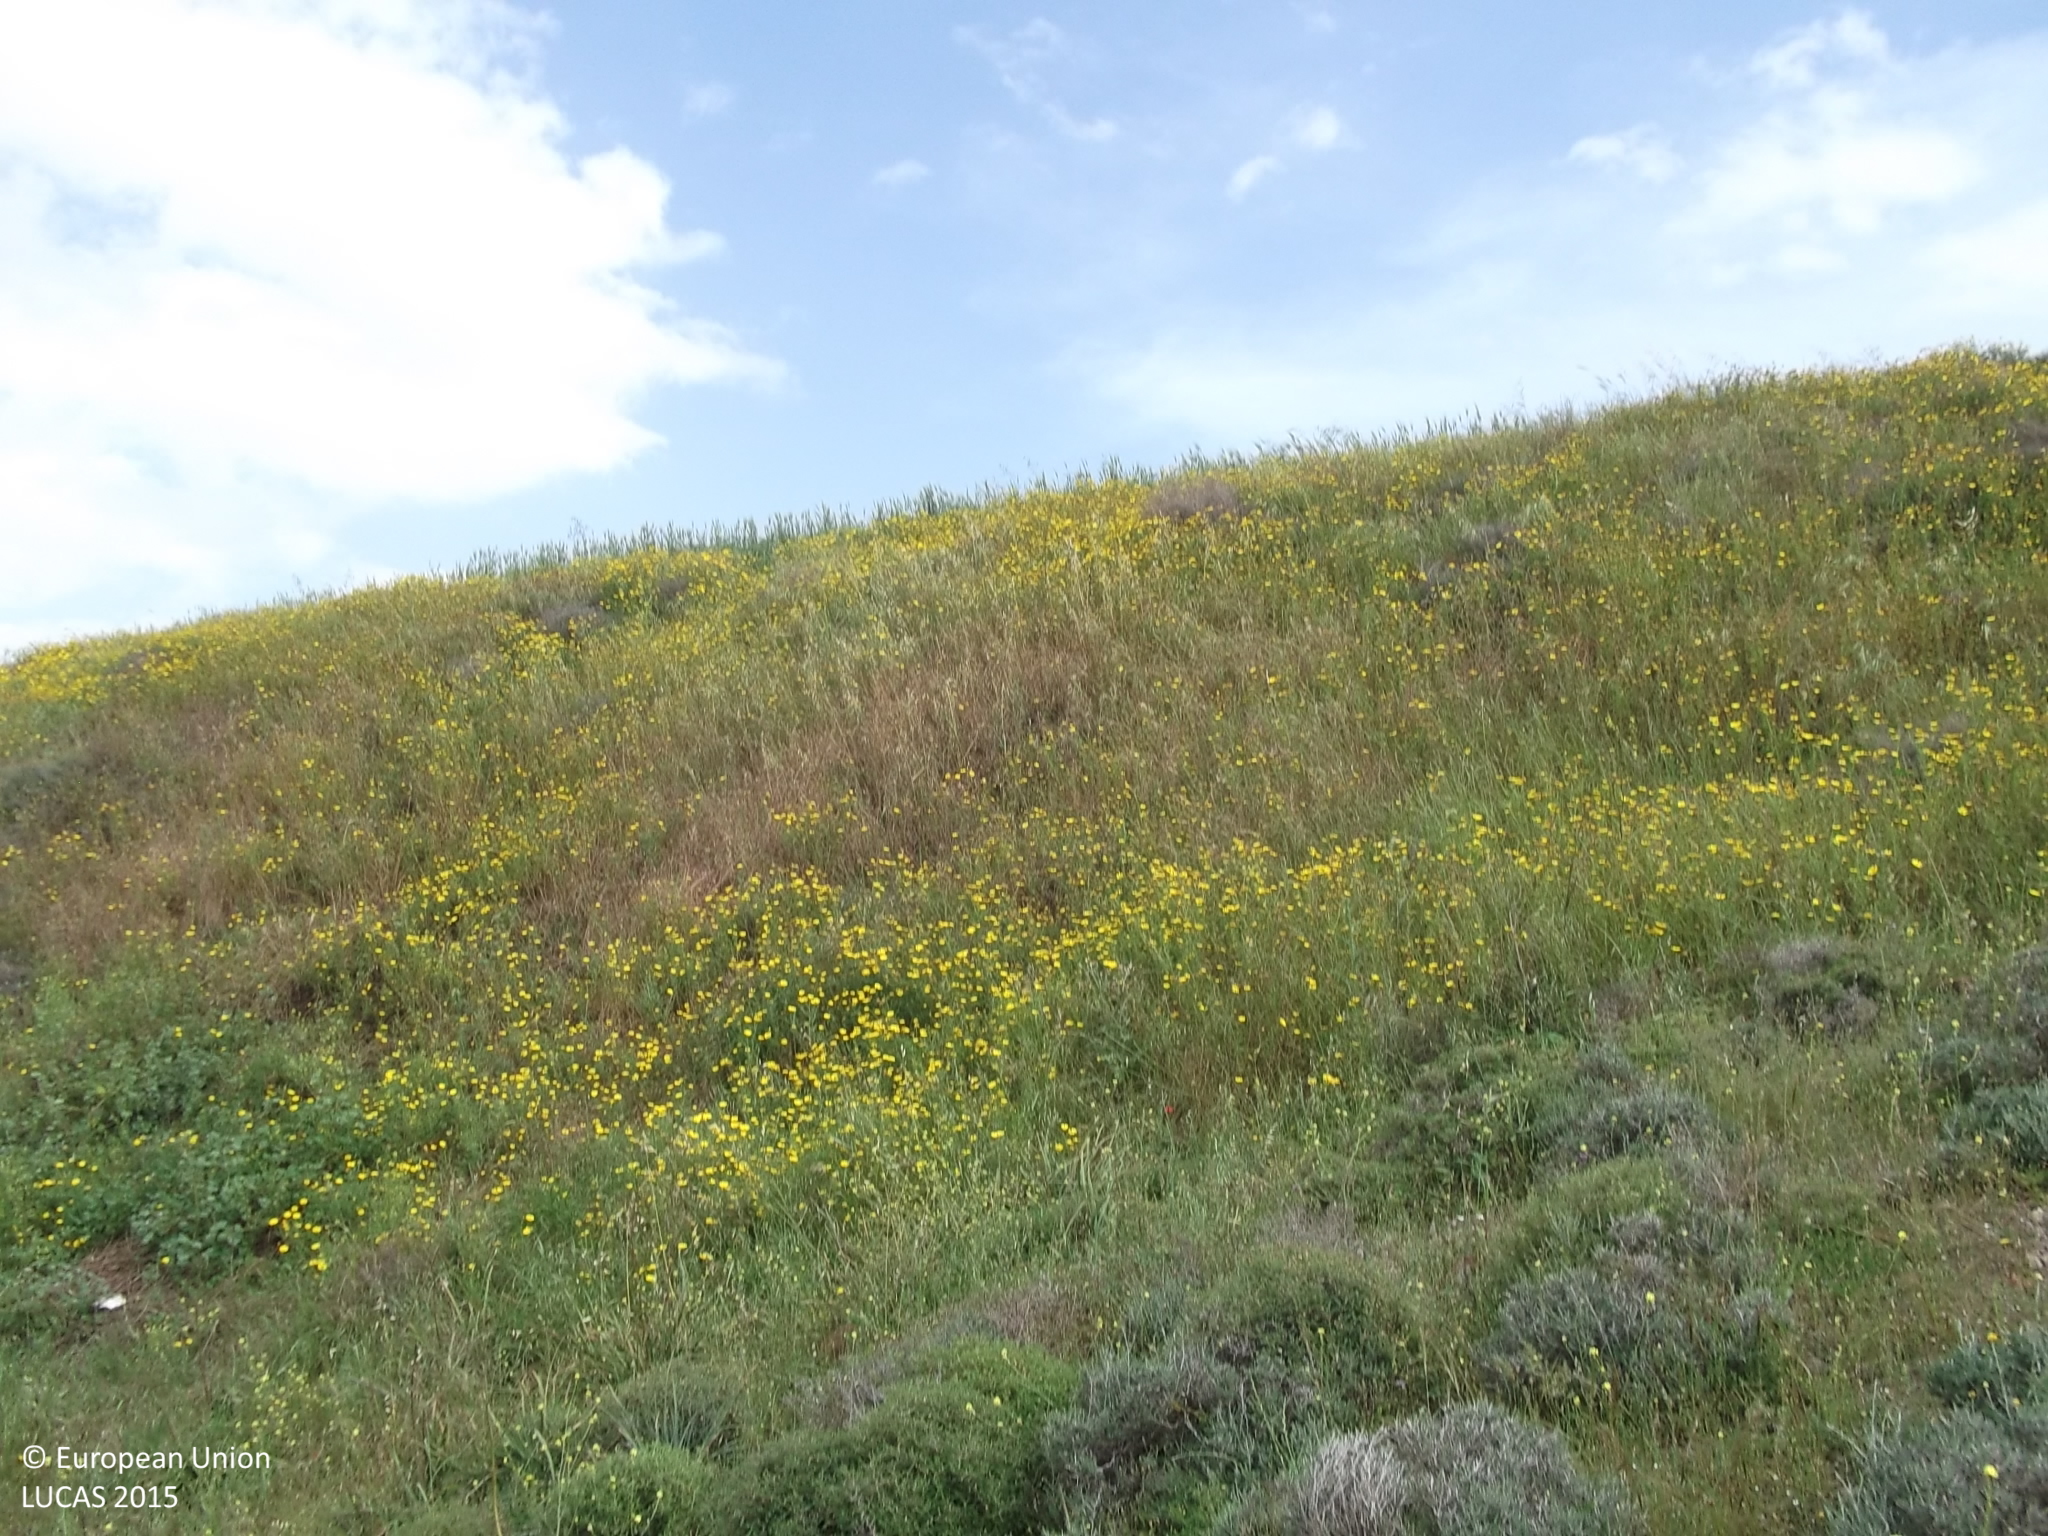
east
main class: Shrubland
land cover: Shrubland without tree cover
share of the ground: > 75 %
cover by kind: shrubs 70 %, herbaceous plants 20 %, unconsolidated bare surface 10 %
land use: Semi-natural and natural areas not in use
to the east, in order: Shrubland without tree cover; Common wheat; Spontaneously vegetated surfaces; Paved roads, cycling and walking lanes; Spontaneously vegetated surfaces; Common wheat; Grassland without tree/shrub cover; Tracks; Grassland without tree/shrub cover
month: April
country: CY
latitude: 35.0096
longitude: 33.6164
